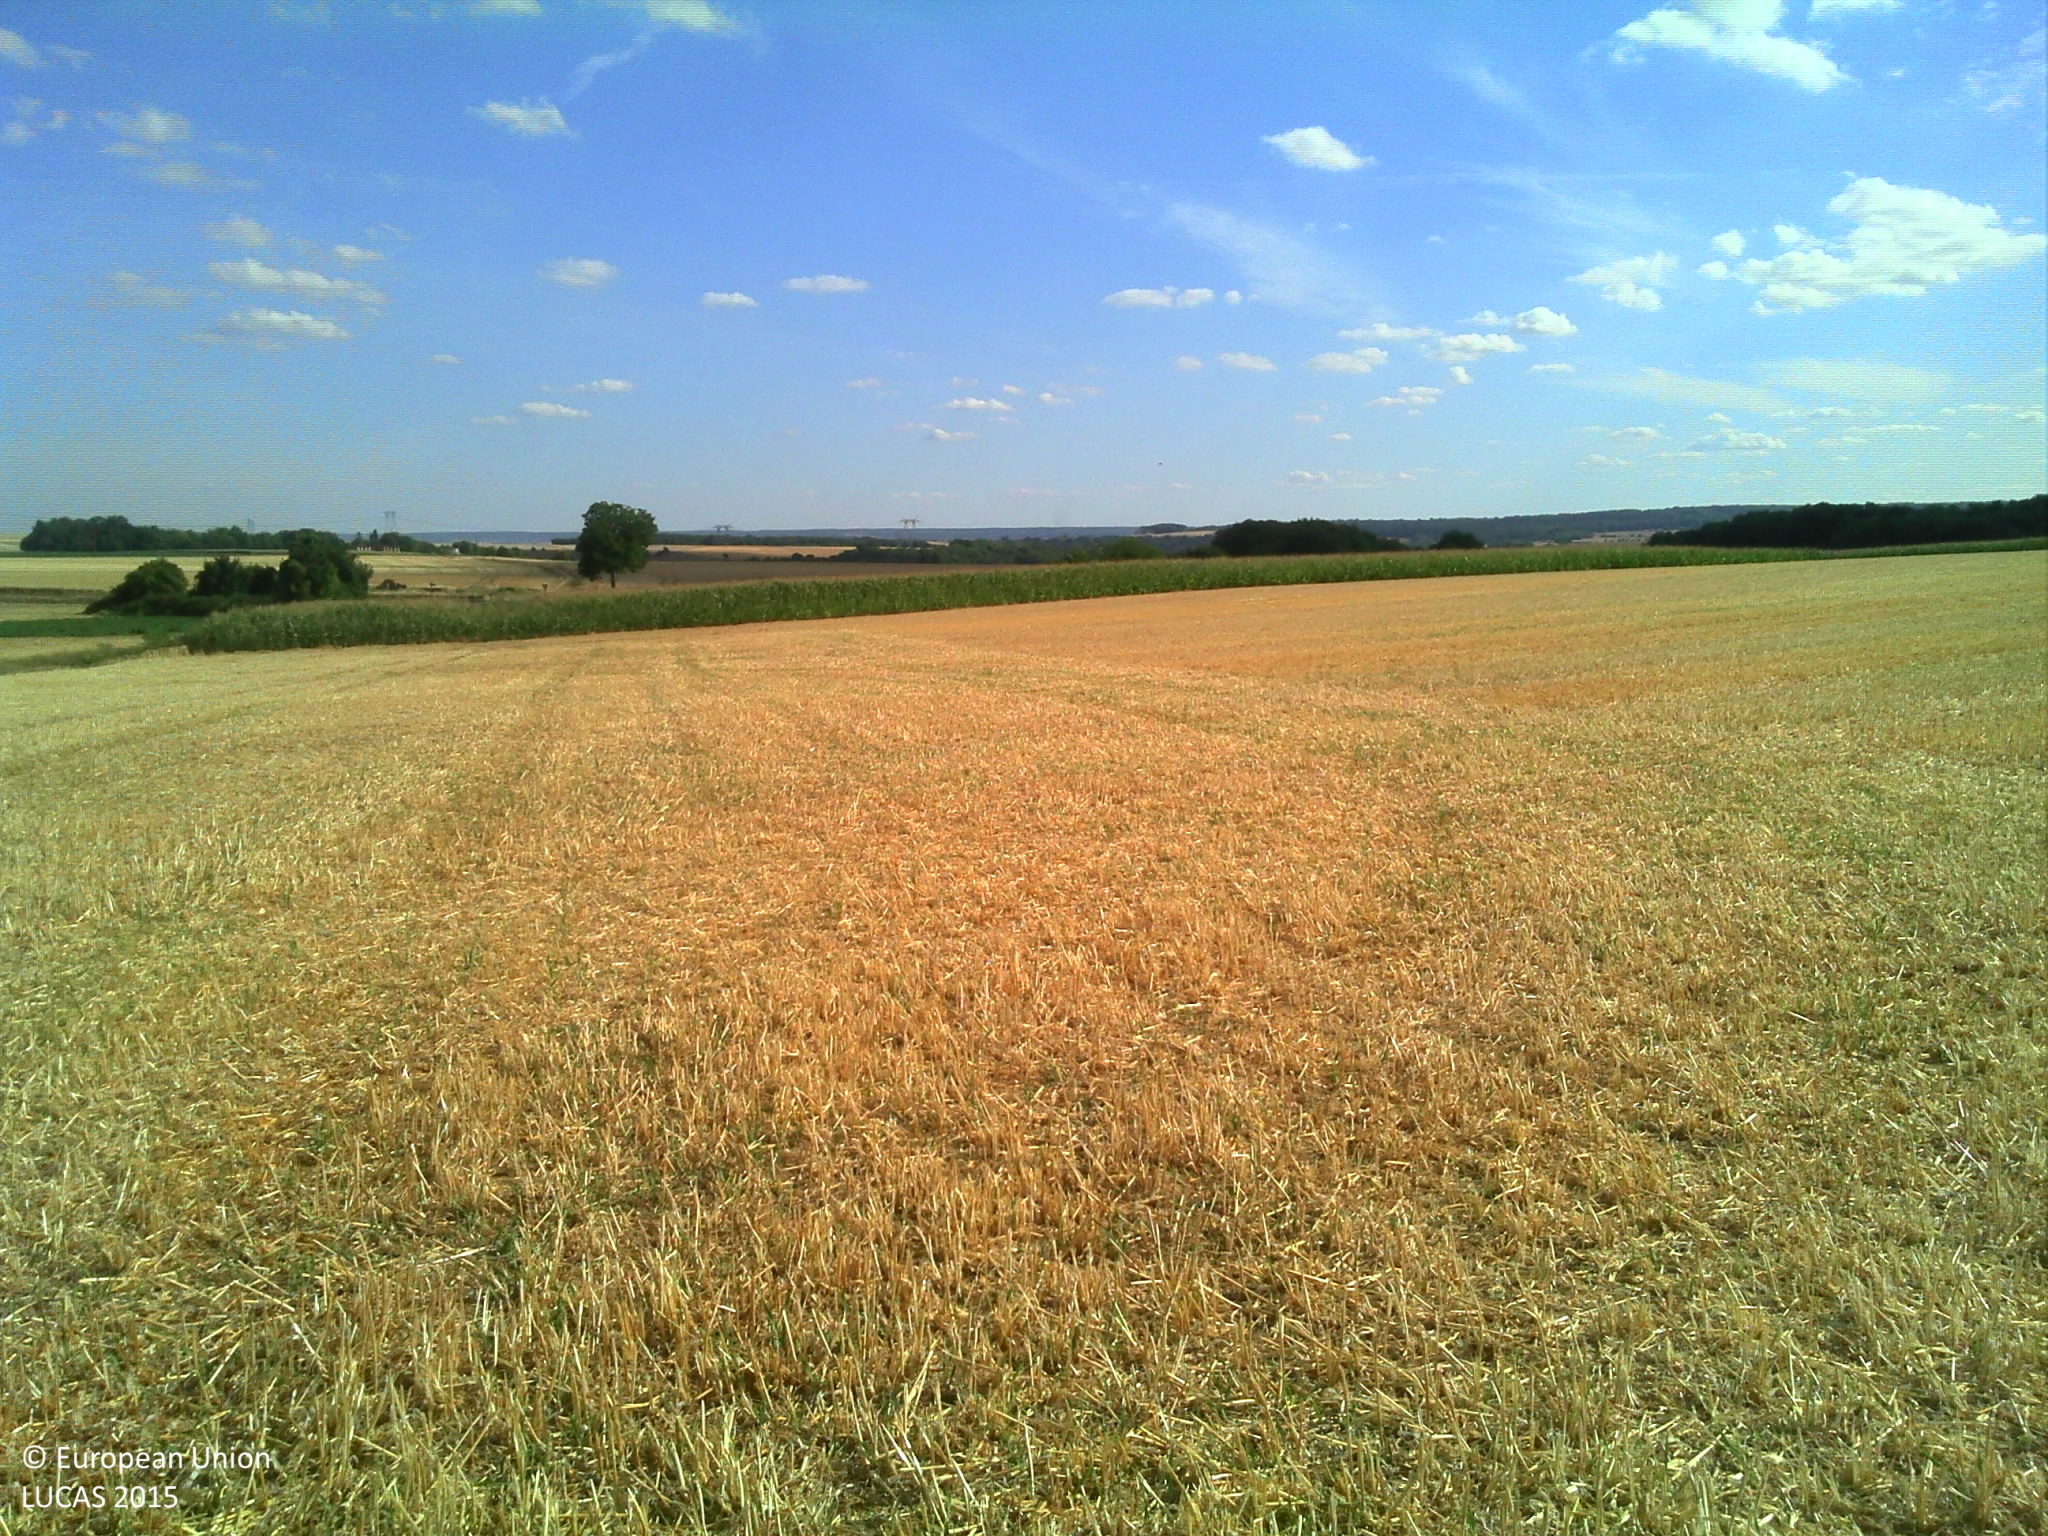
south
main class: Cropland
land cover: Common wheat
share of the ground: > 75 %
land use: Agriculture (excluding fallow land and kitchen gardens)
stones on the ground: < 10 %
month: August
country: FR
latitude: 49.0620
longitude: 1.8689
